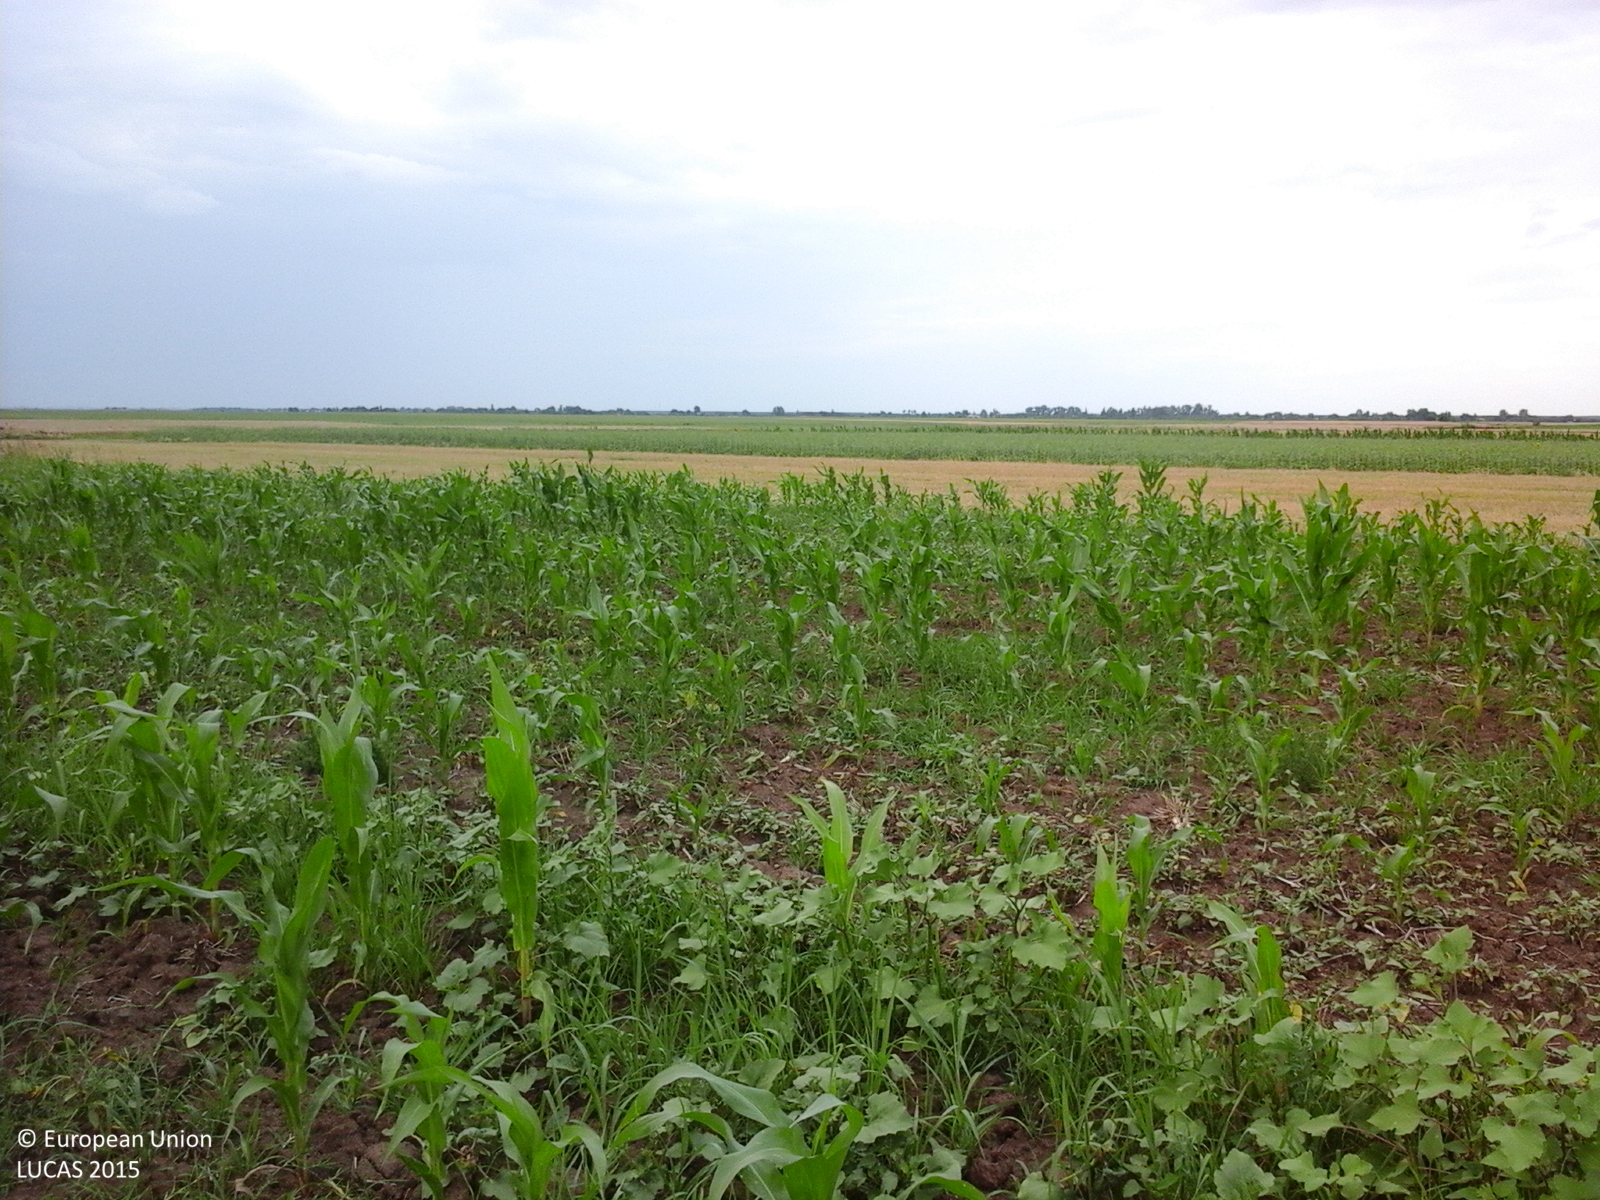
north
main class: Cropland
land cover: Maize
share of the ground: 50 - 75 %
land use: Agriculture (excluding fallow land and kitchen gardens)
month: July
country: RO
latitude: 44.2767
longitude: 25.3853
